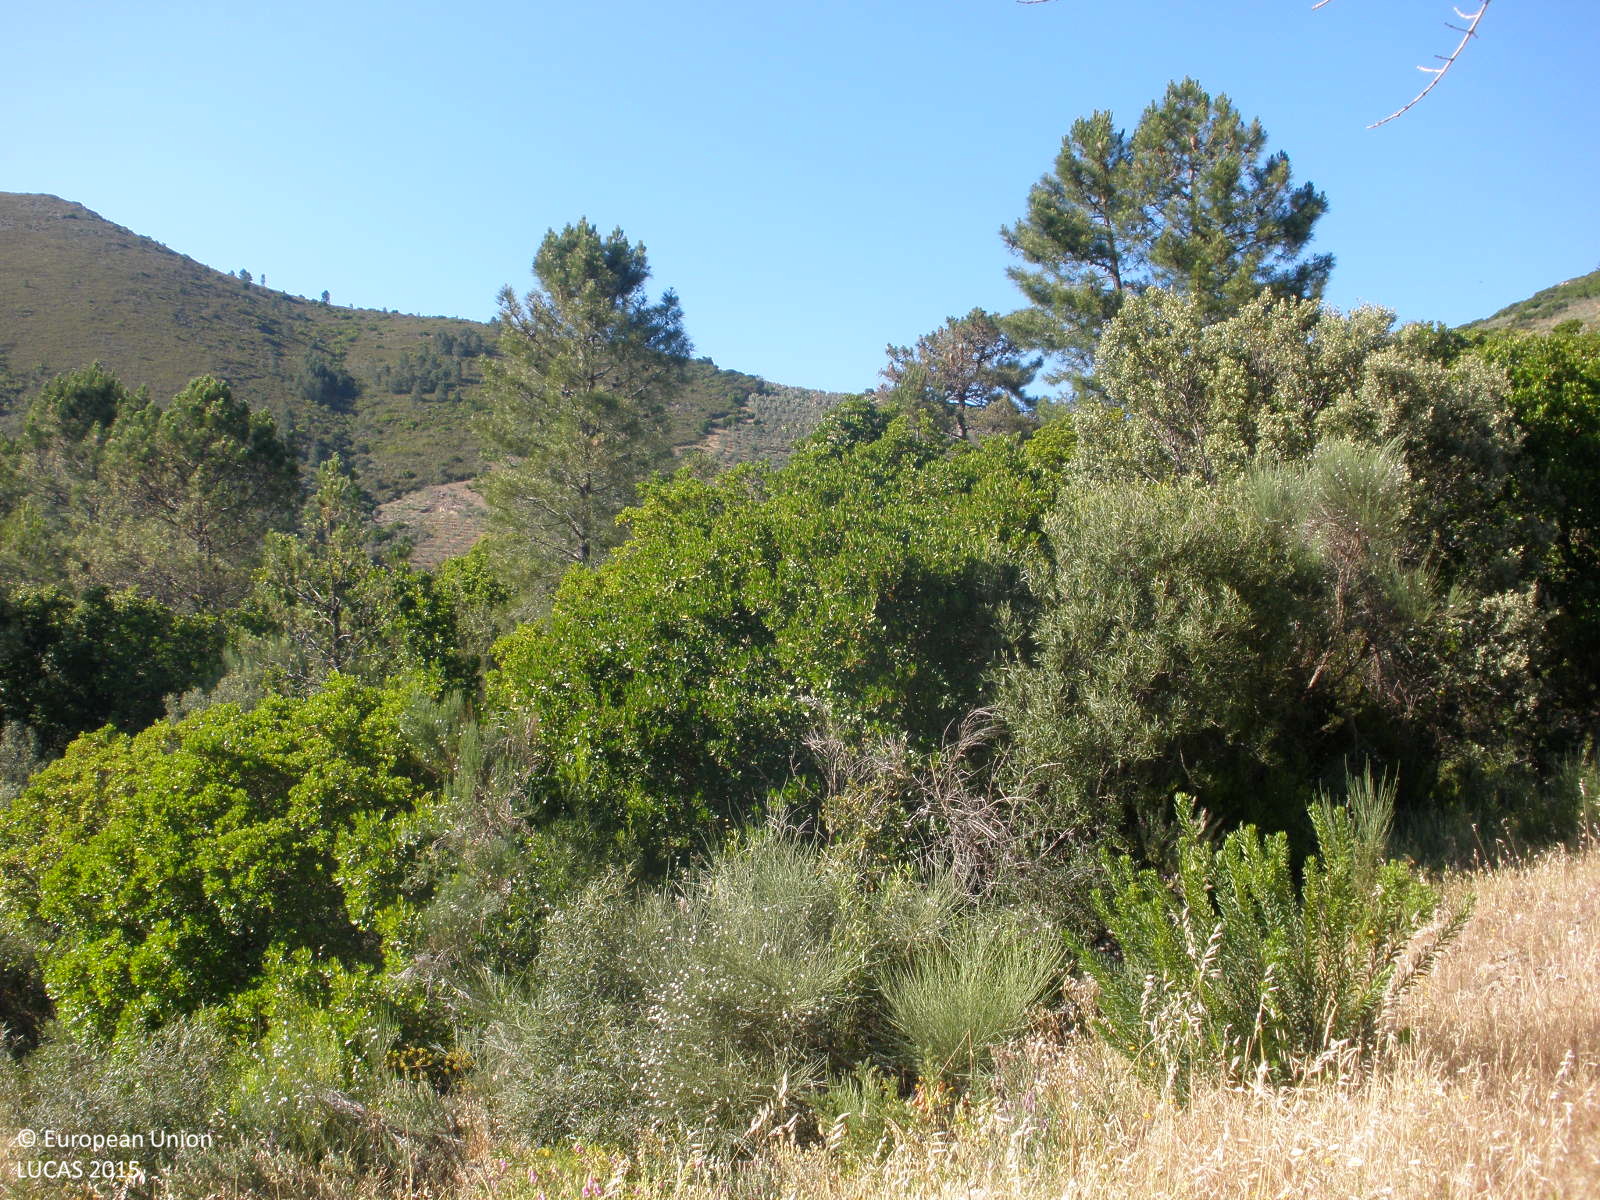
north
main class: Cropland
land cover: Olive groves
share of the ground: 50 - 75 %
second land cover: Spontaneously vegetated surfaces
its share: > 75 %
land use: Agriculture (excluding fallow land and kitchen gardens)
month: May
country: ES
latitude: 40.2905
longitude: -6.2054
